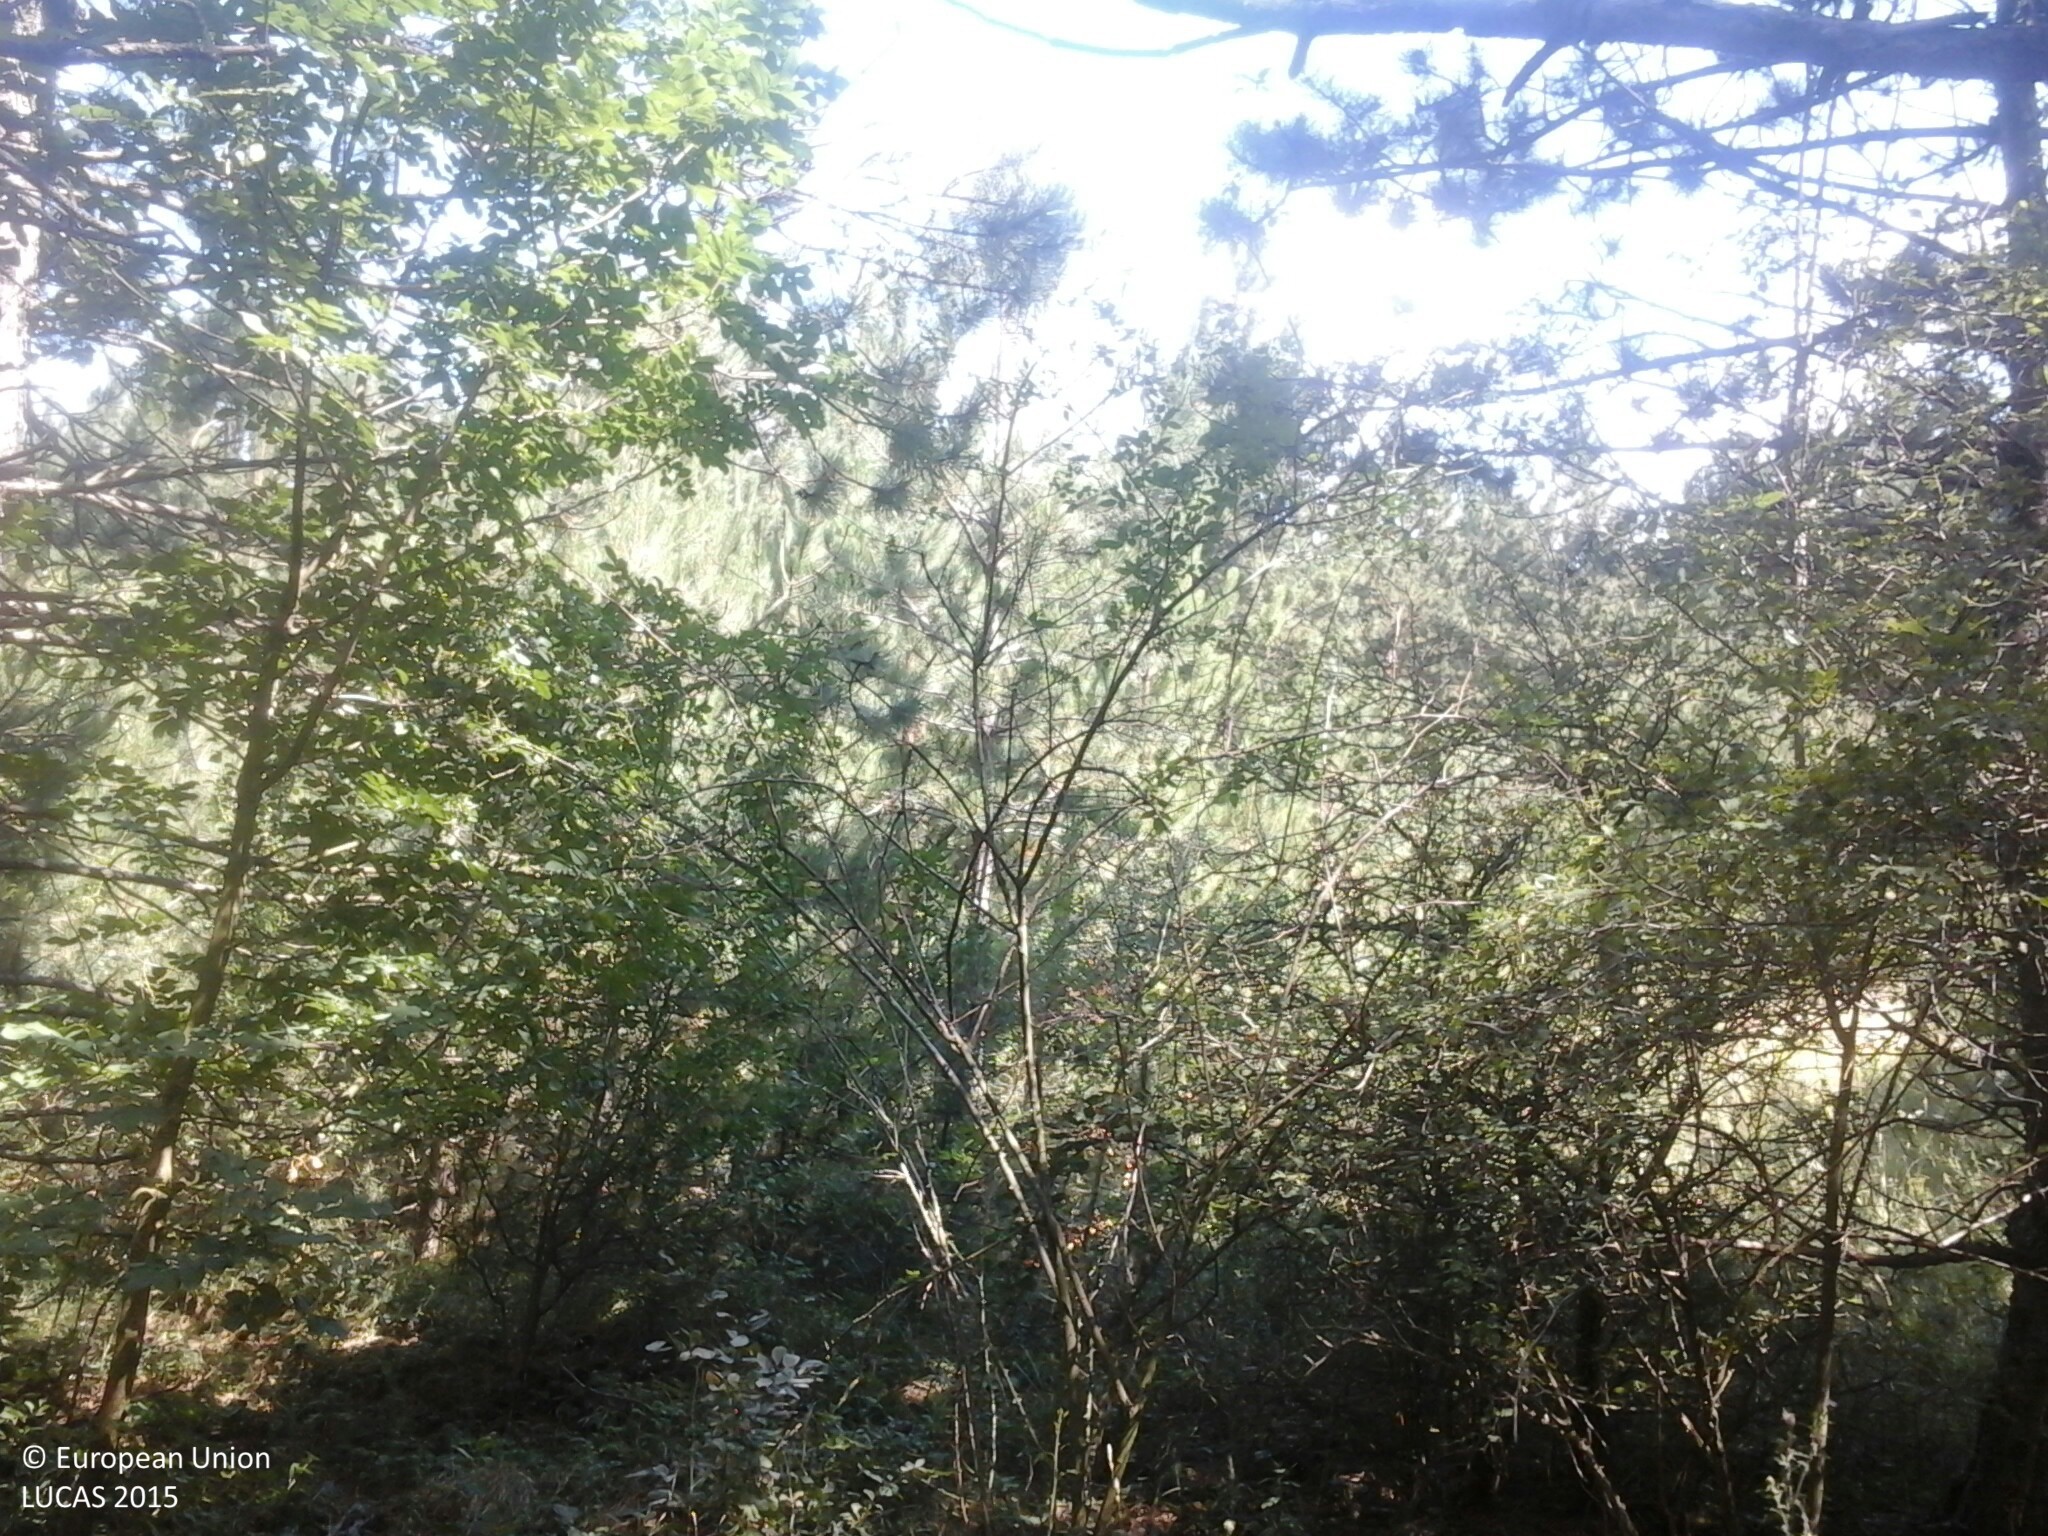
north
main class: Woodland
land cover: Other coniferous woodland
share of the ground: > 75 %
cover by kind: coniferous forest trees 70 %, shrubs 20 %, herbaceous plants 10 %
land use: Forestry
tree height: < 5 m
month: July
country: HU
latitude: 47.2154
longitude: 18.1577
